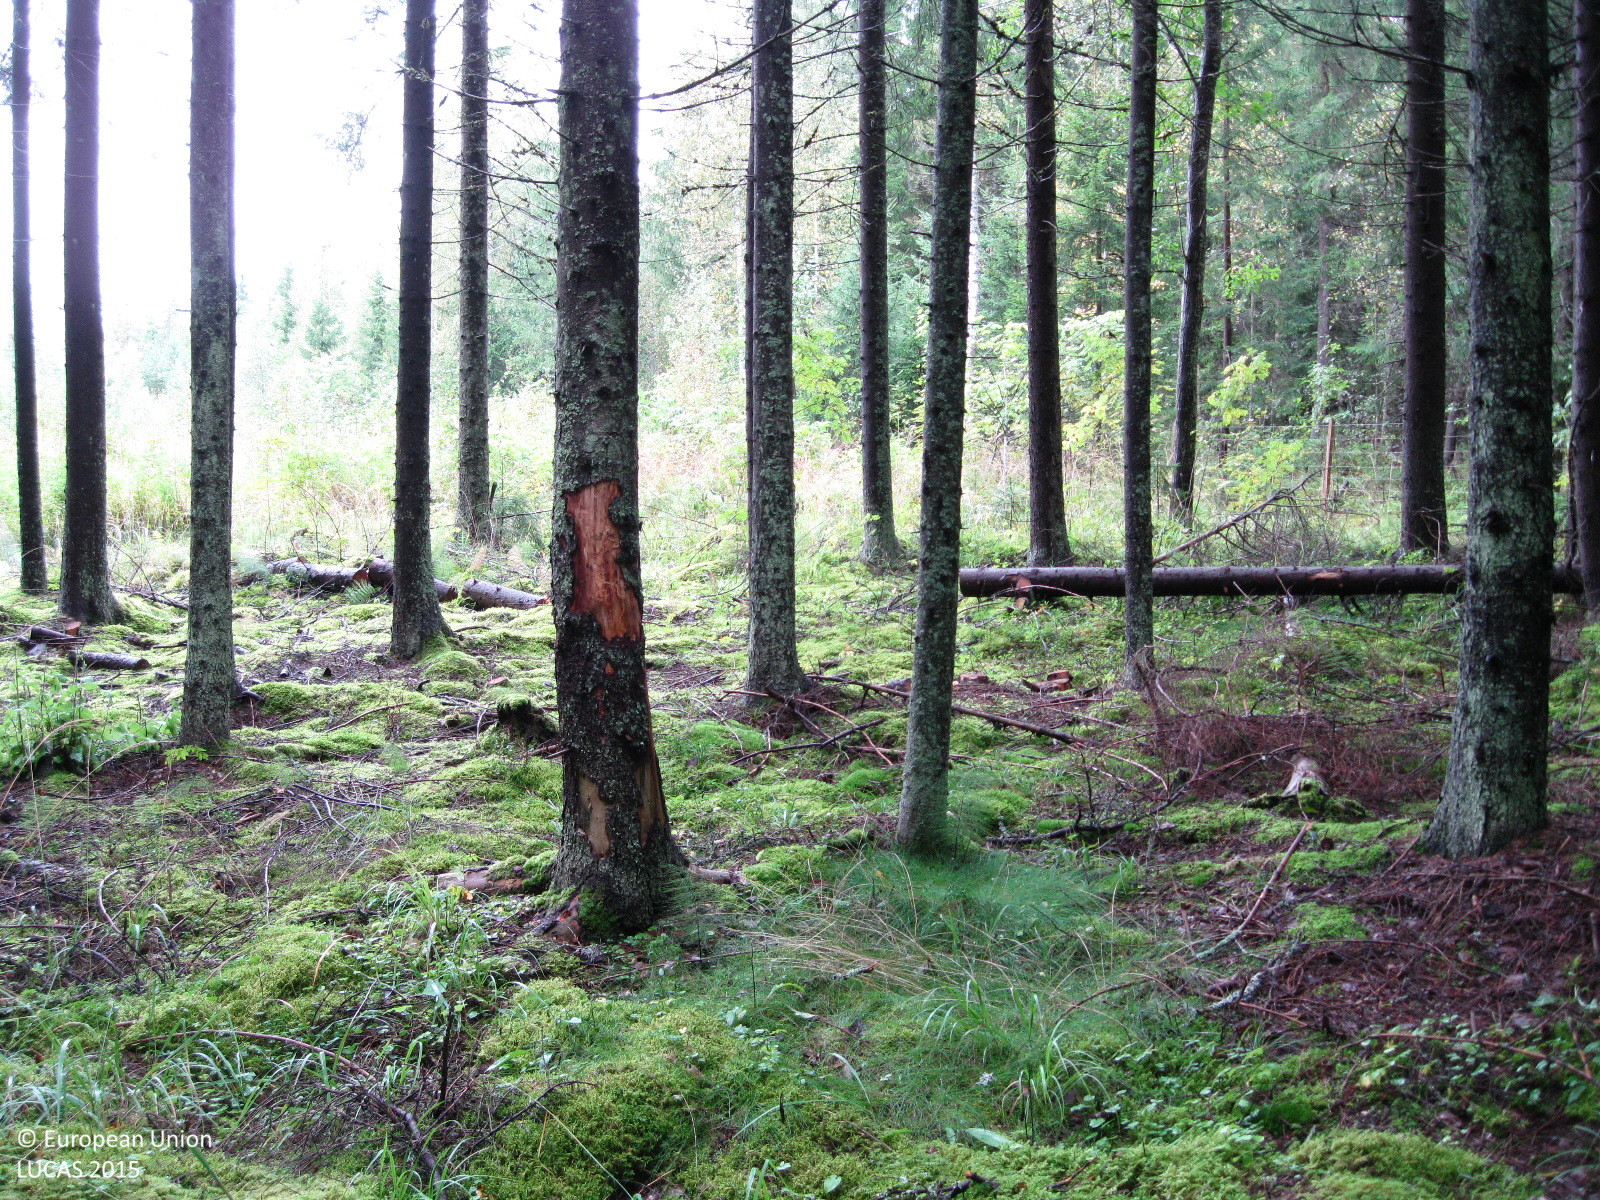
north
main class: Woodland
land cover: Spruce dominated coniferous woodland
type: boreal forest
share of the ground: > 75 %
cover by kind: coniferous forest trees 70 %, broadleaved forest trees 10 %, herbaceous plants 10 %, lichens and mosses 10 %
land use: Forestry
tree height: > 5 m
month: September
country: FI
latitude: 60.3875
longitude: 24.6054
